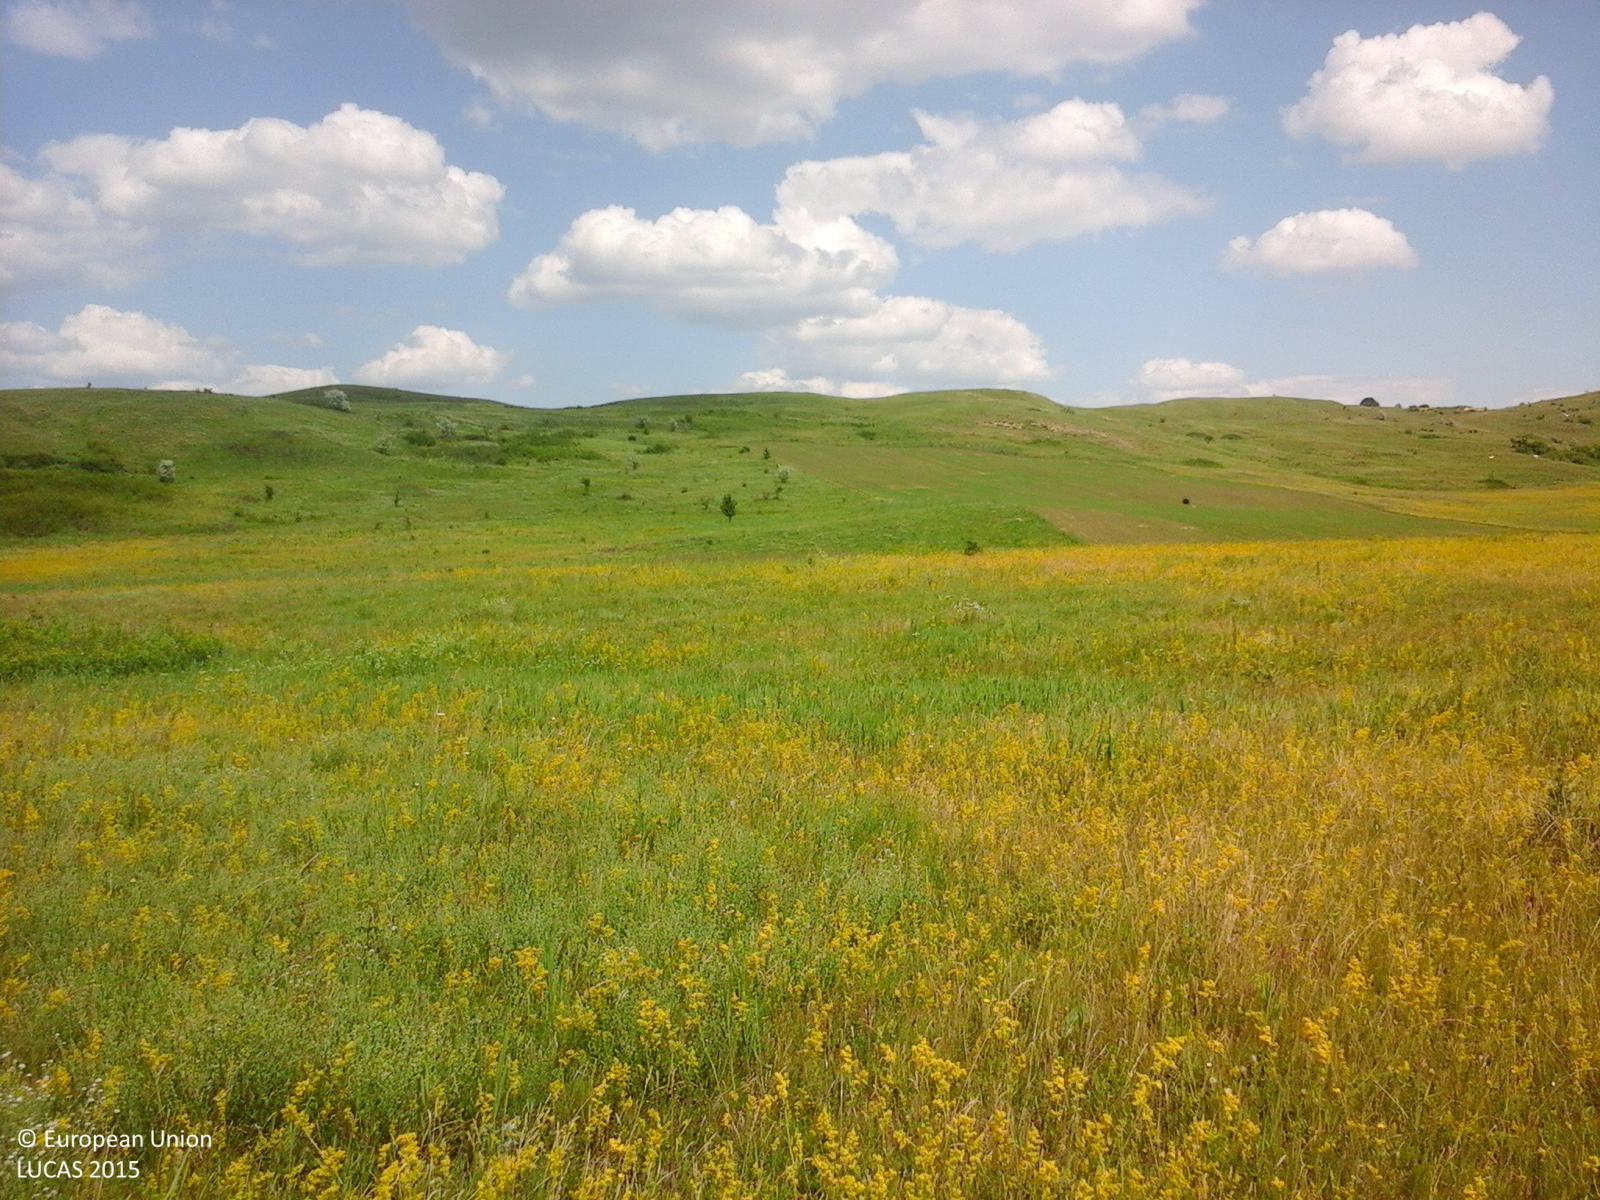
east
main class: Grassland
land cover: Grassland without tree/shrub cover
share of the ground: > 75 %
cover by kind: herbaceous plants 100 %
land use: Agriculture (excluding fallow land and kitchen gardens)
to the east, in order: Grassland without tree/shrub cover; Inland marshes; Grassland without tree/shrub cover; Grassland with sparse tree/shrub cover
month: June
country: RO
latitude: 47.9068
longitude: 26.3696
